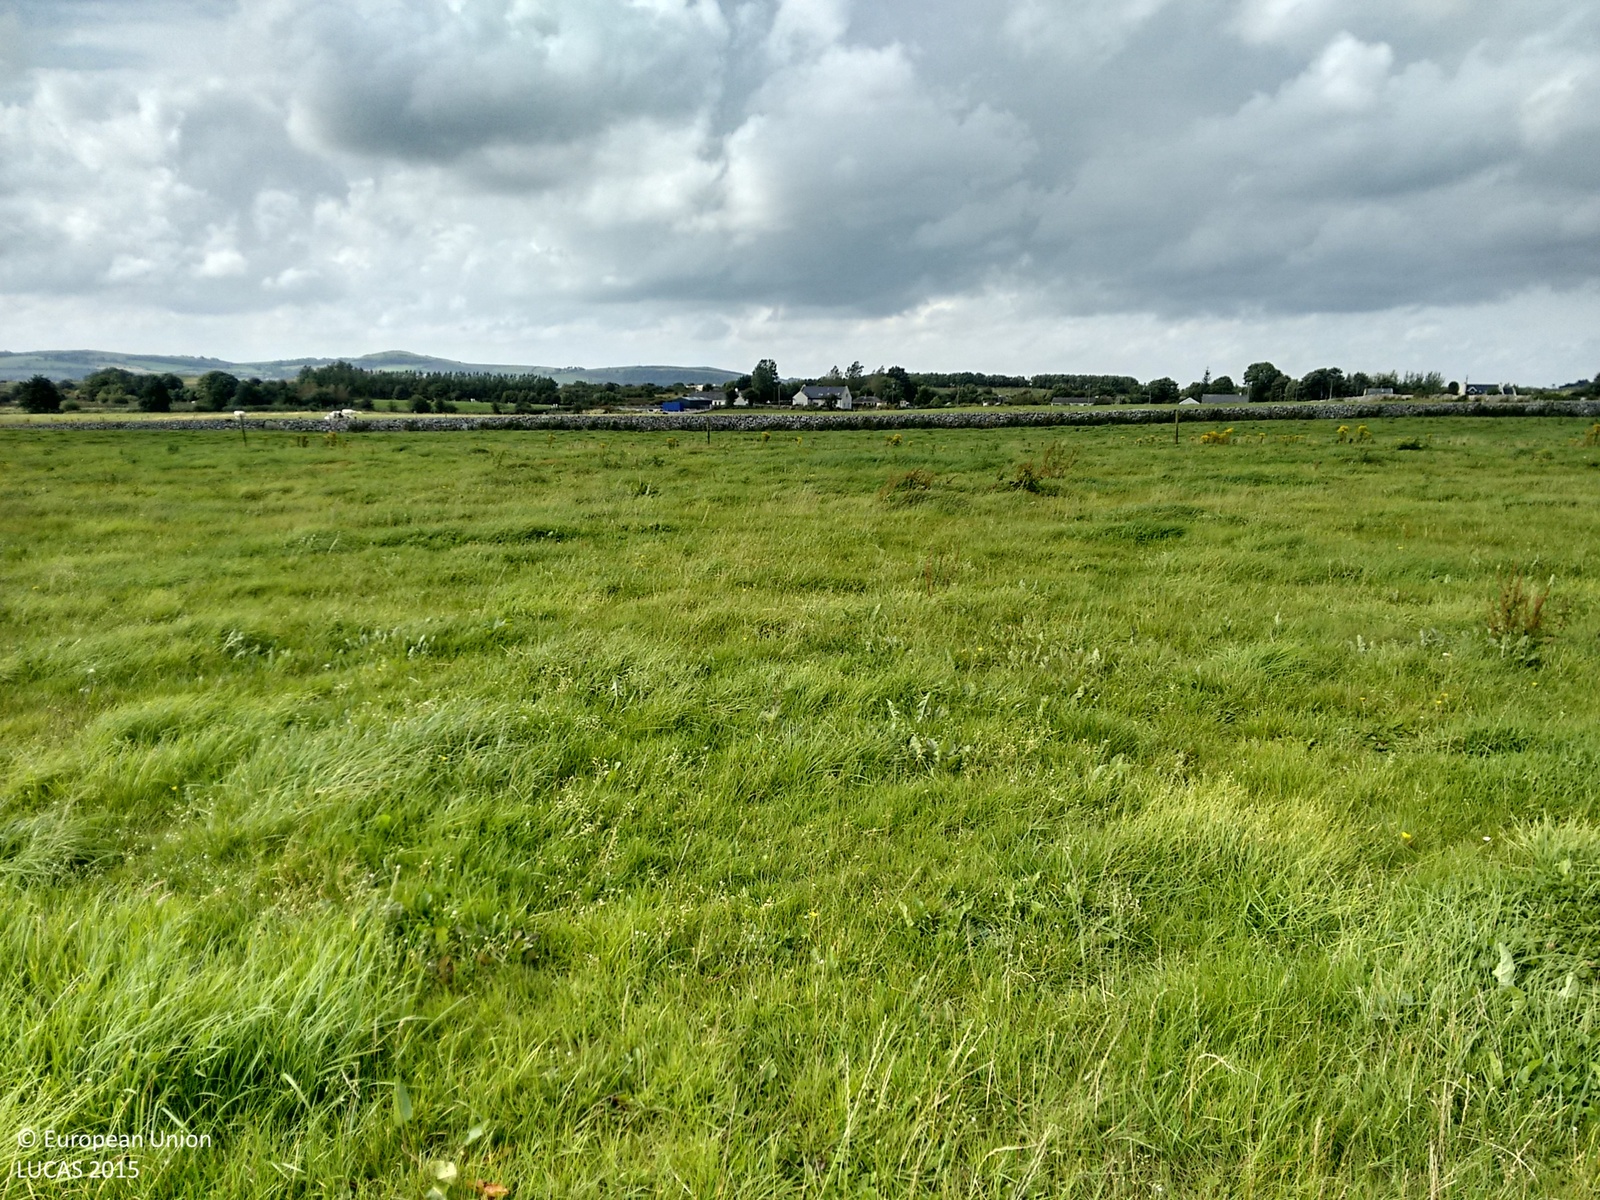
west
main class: Grassland
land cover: Grassland without tree/shrub cover
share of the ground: > 75 %
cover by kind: herbaceous plants 100 %
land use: Agriculture (excluding fallow land and kitchen gardens)
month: September
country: IE
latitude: 52.6095
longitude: -9.0433
